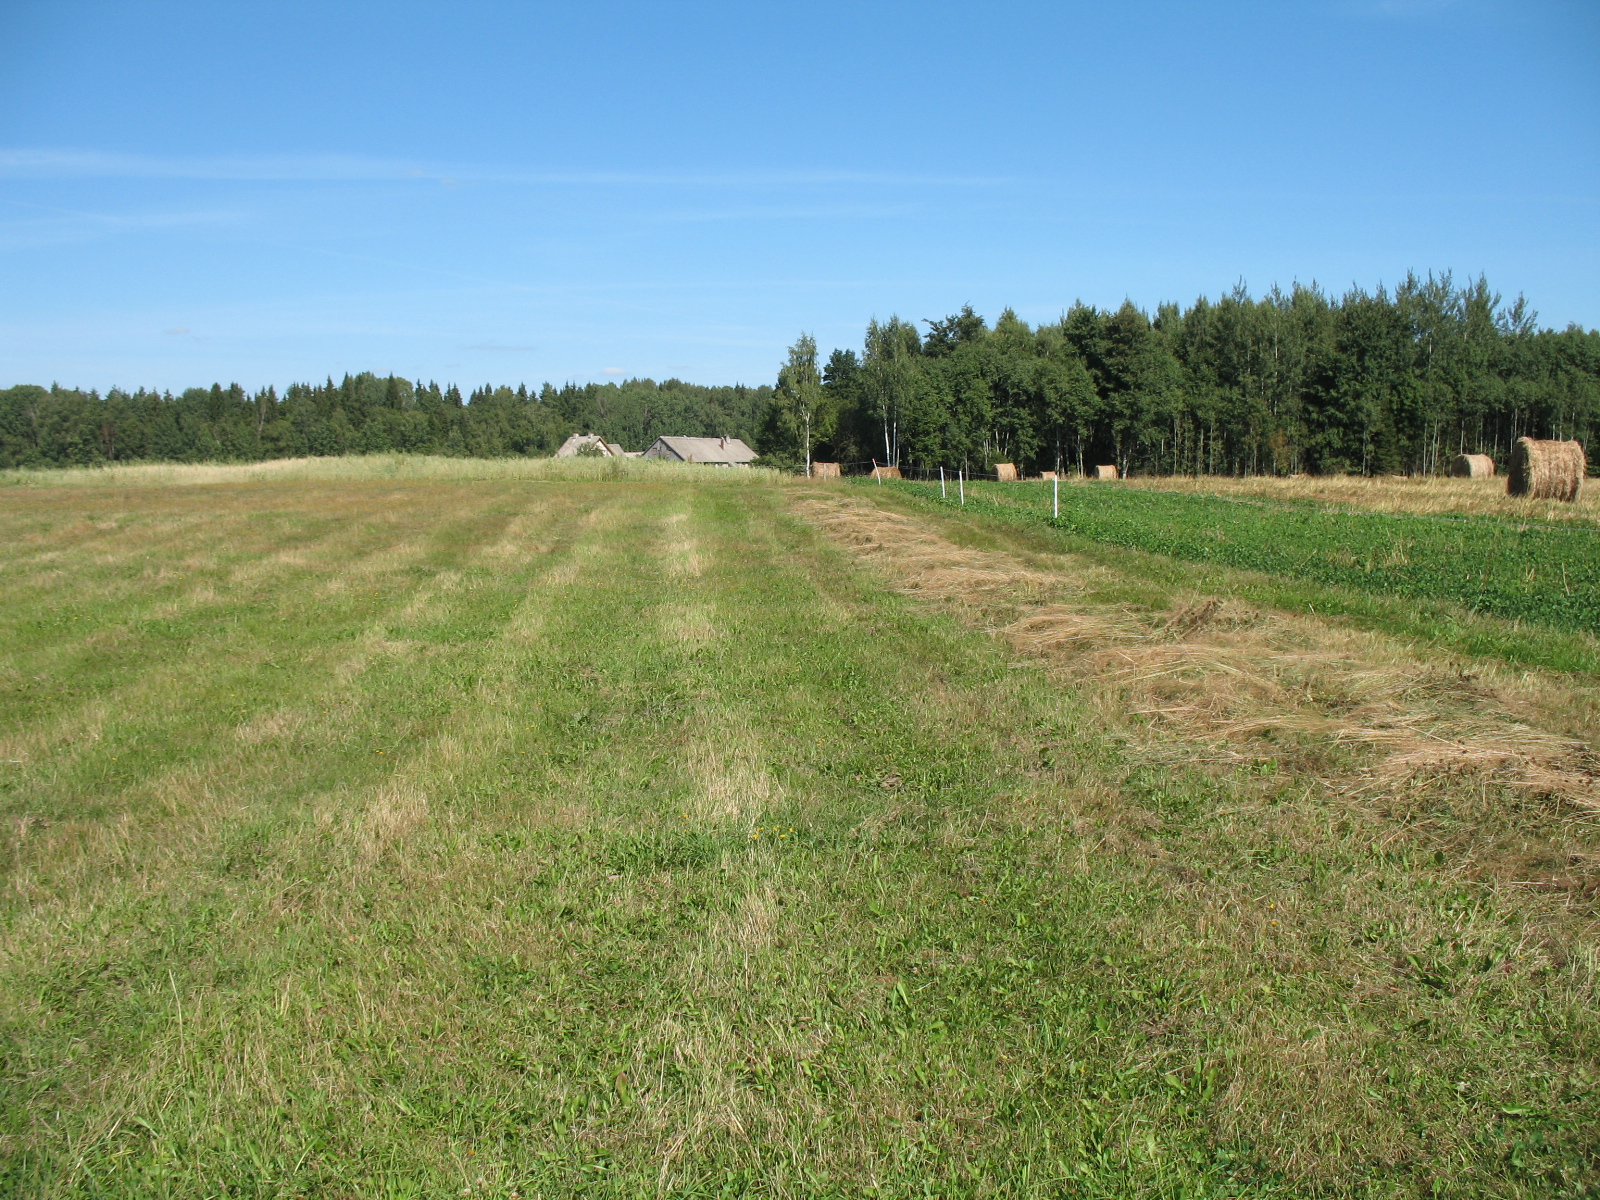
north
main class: Grassland
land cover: Grassland without tree/shrub cover
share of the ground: > 75 %
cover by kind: herbaceous plants 95 %, unconsolidated bare surface 5 %
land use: Agriculture (excluding fallow land and kitchen gardens)
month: August
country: LV
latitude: 56.4404
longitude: 26.0135
